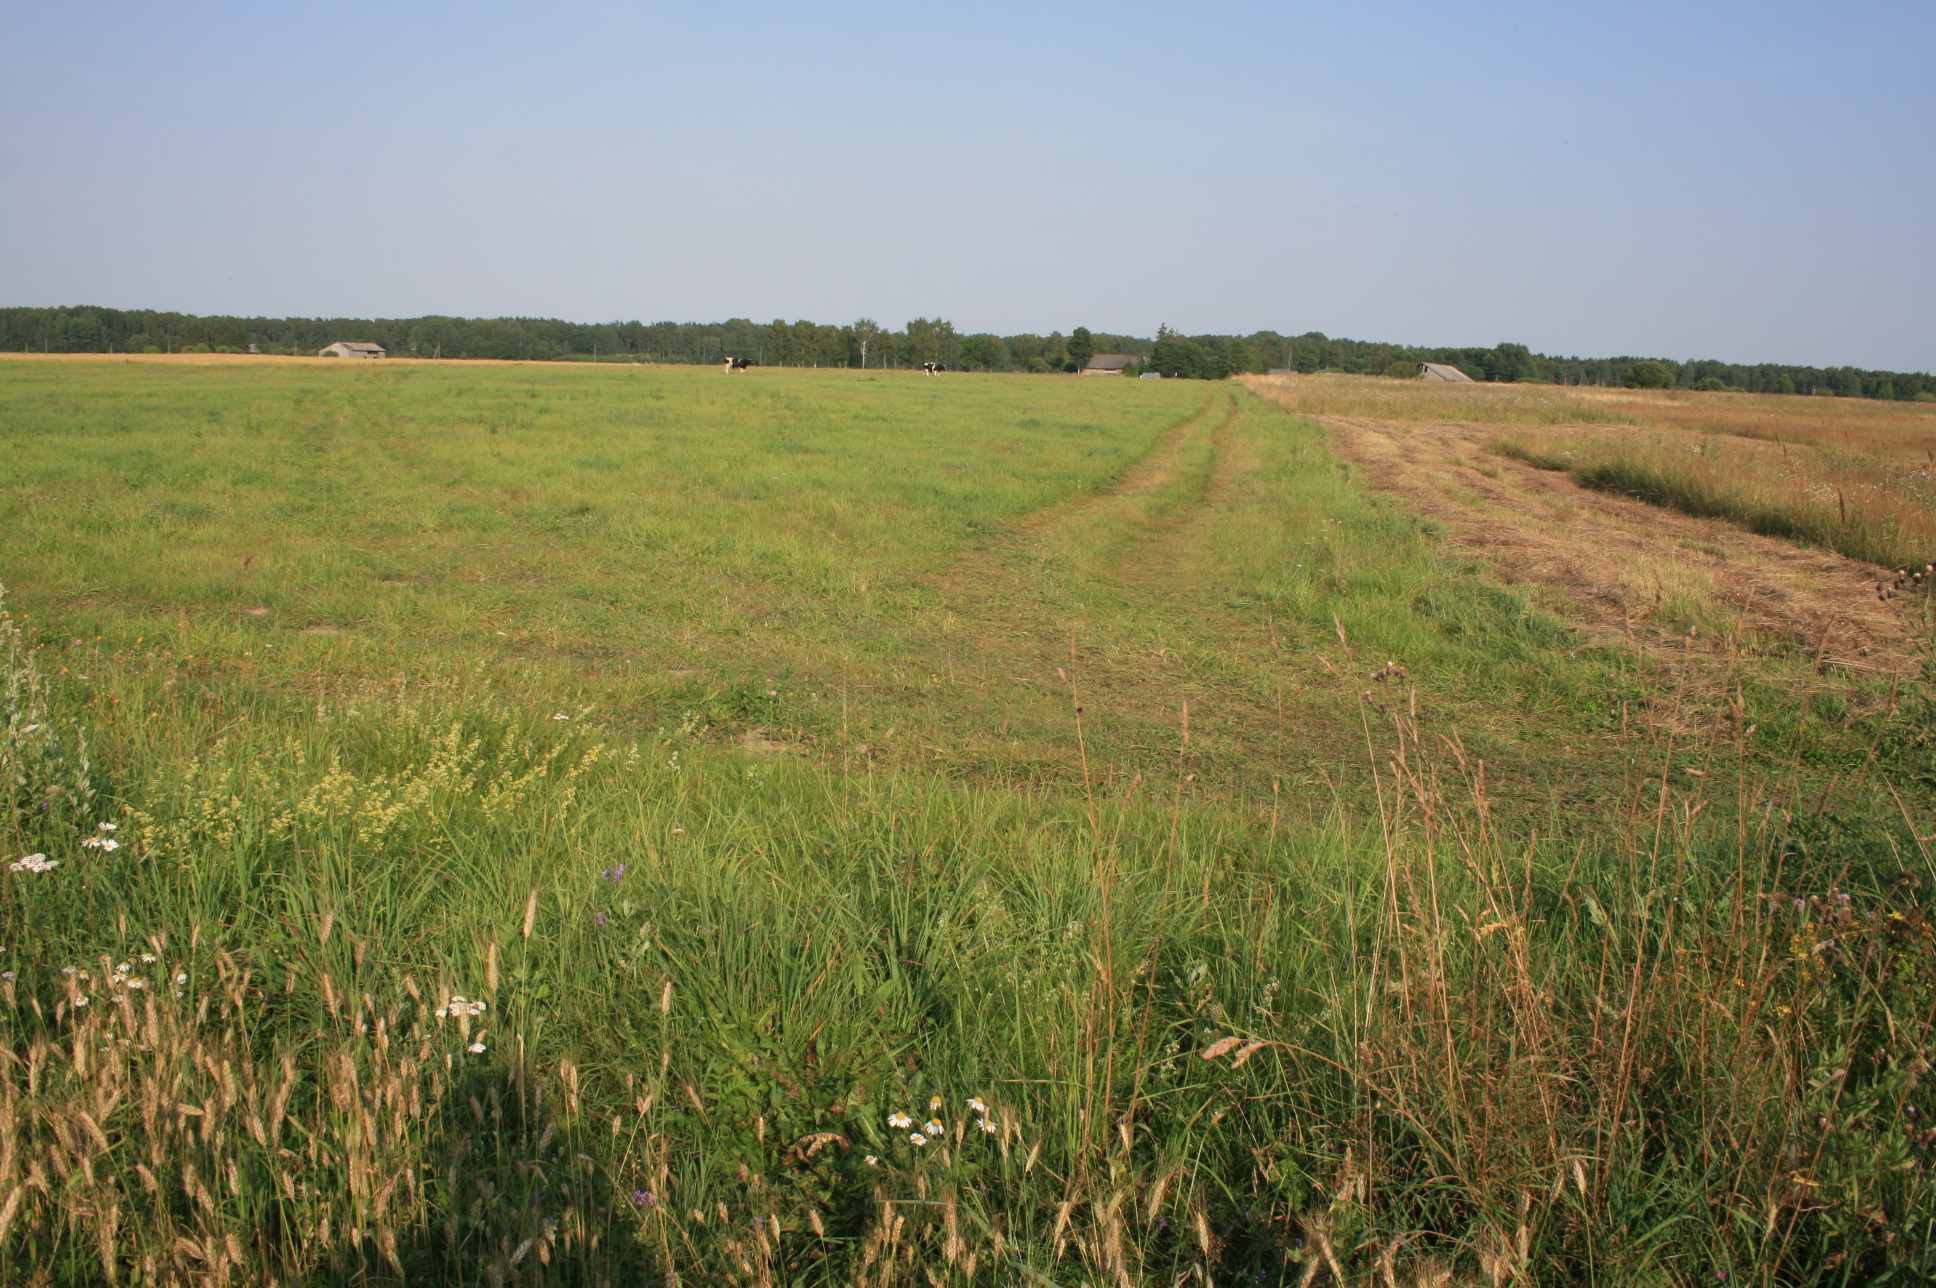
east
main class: Cropland
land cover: Durum wheat
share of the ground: > 75 %
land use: Agriculture (excluding fallow land and kitchen gardens)
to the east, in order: Durum wheat; Grassland without tree/shrub cover
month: August
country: LT
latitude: 55.5561
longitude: 21.5398
